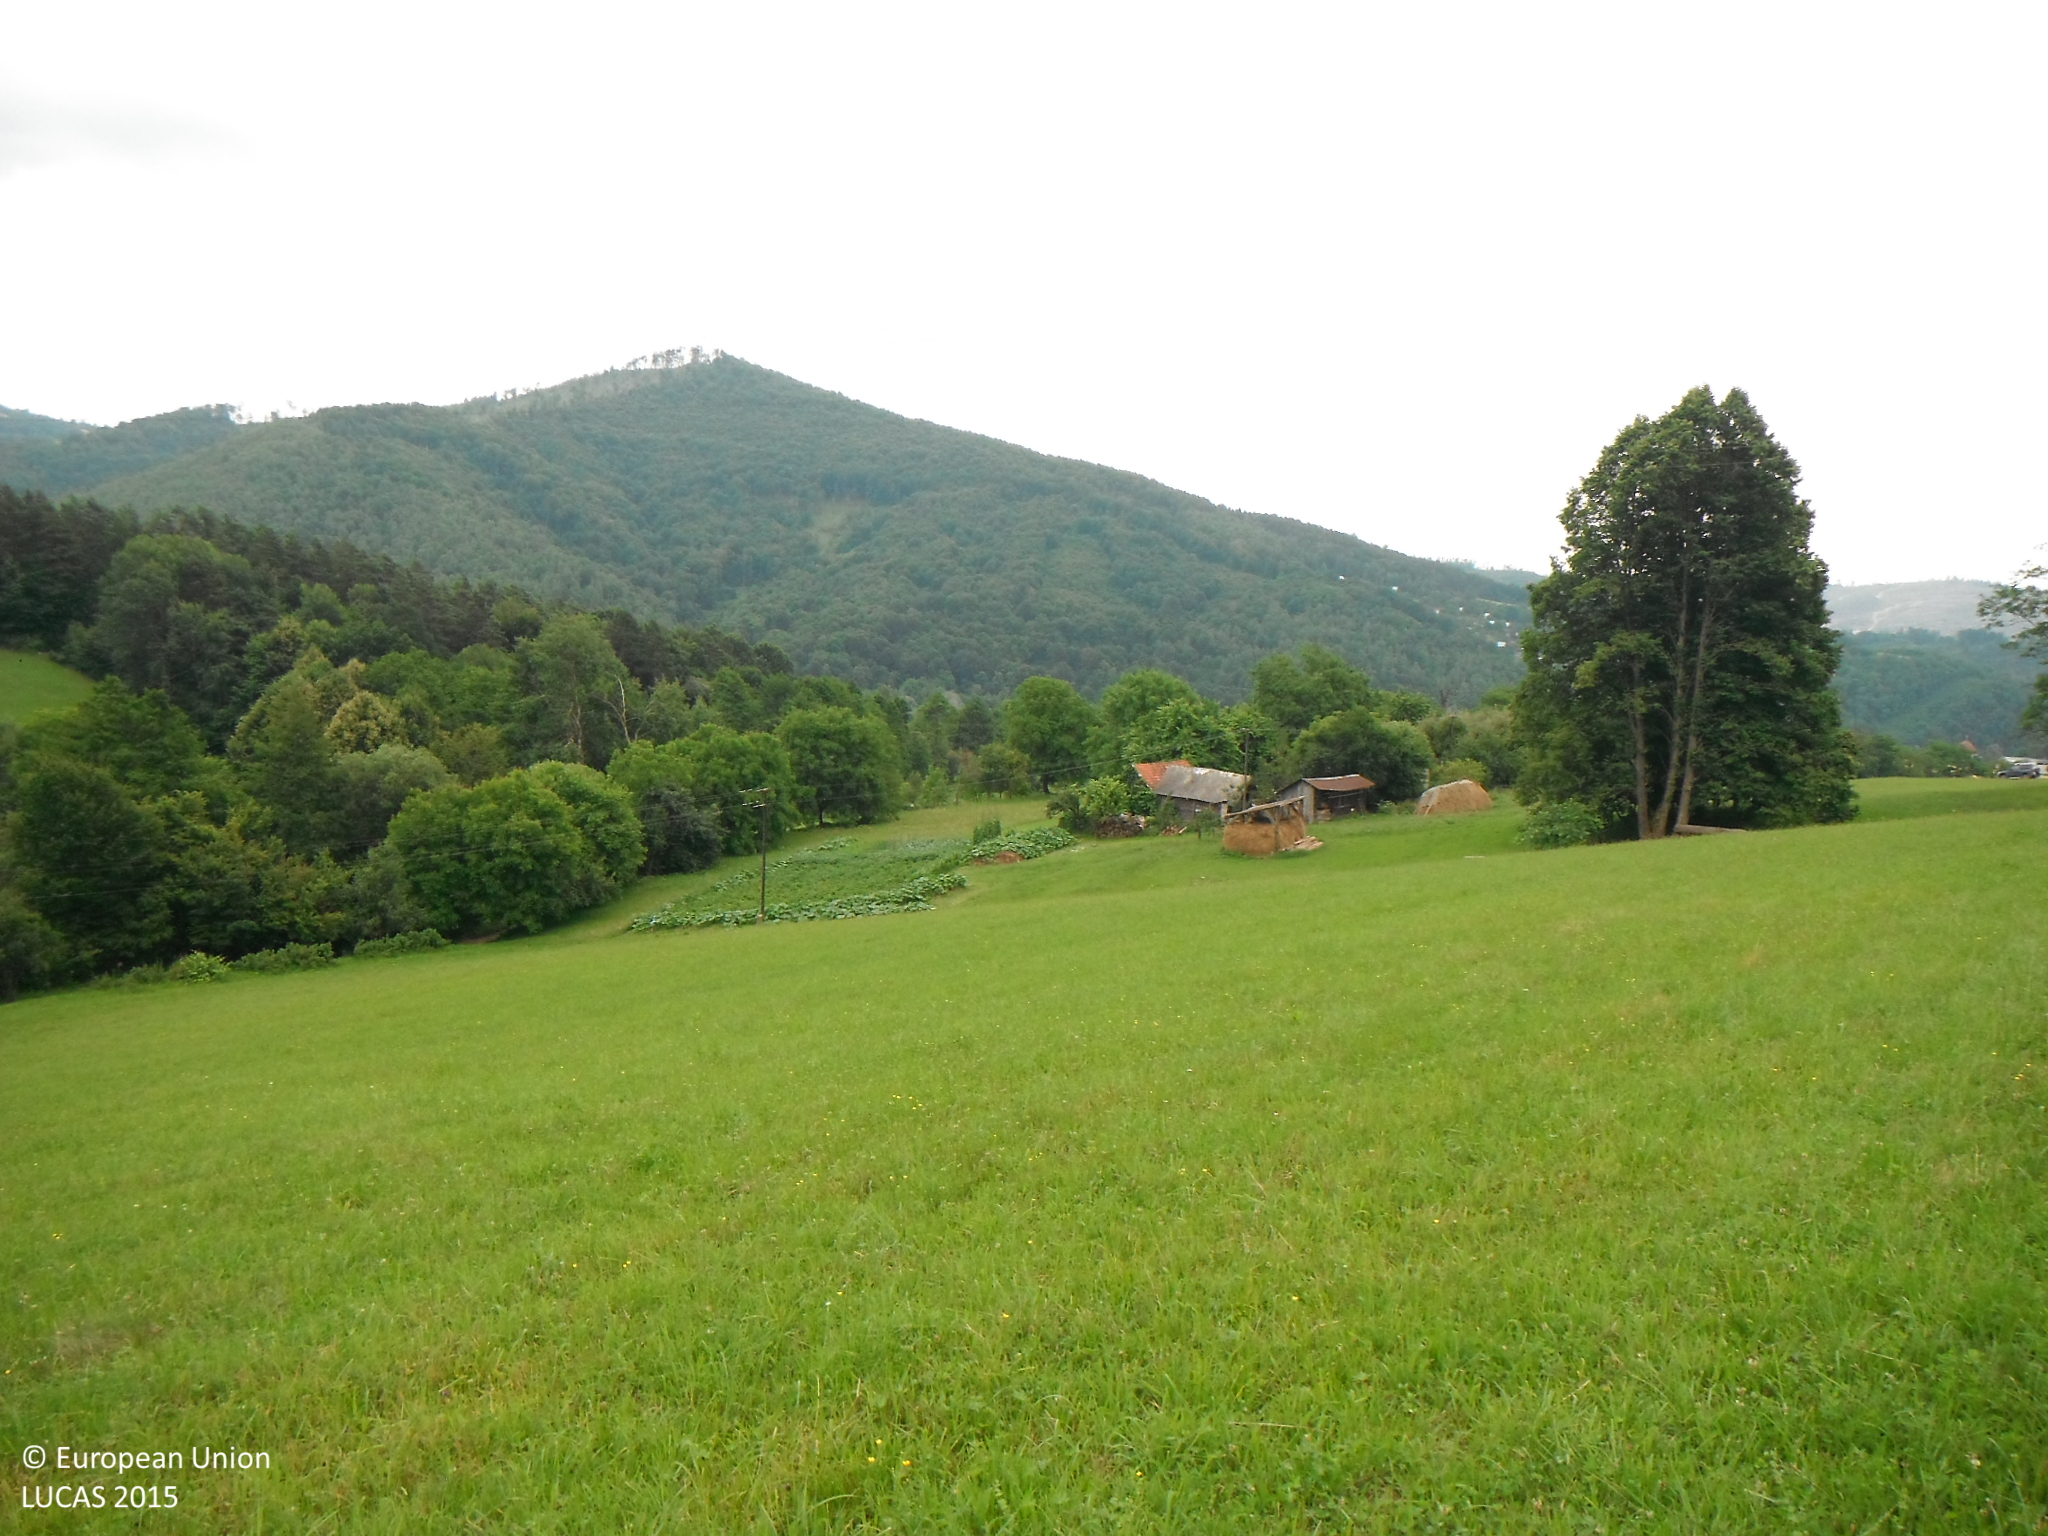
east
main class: Grassland
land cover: Grassland without tree/shrub cover
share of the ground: > 75 %
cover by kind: herbaceous plants 100 %
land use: Agriculture (excluding fallow land and kitchen gardens)
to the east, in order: Grassland without tree/shrub cover; Electric lines; Grassland without tree/shrub cover; Lines of trees; Tracks; Broadleaved woodland; Grassland without tree/shrub cover; Spontaneously vegetated surfaces
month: June
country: SK
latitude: 48.5890
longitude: 19.9397
